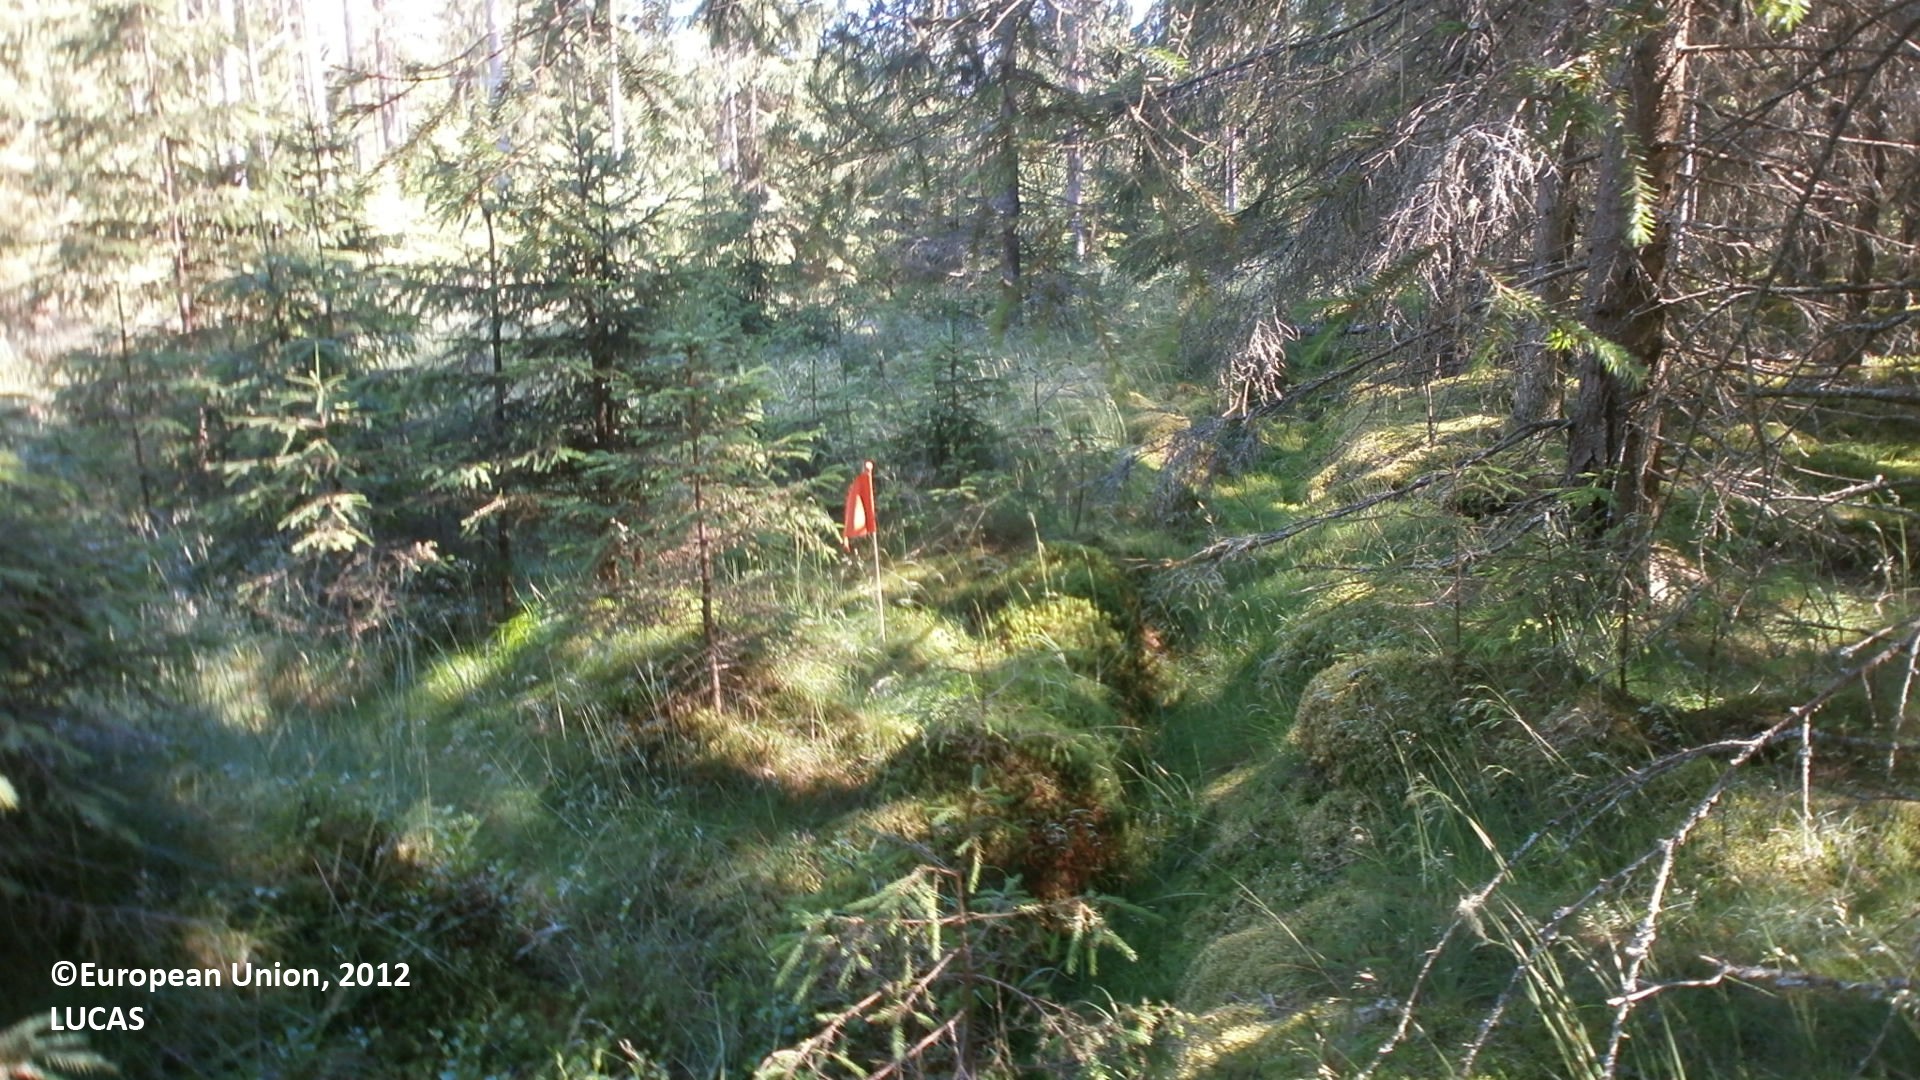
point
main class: Woodland
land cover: Spruce dominated coniferous woodland
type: boreal forest
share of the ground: 50 - 75 %
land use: Forestry
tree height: > 5 m
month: July
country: FI
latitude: 64.3375
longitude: 24.0741
